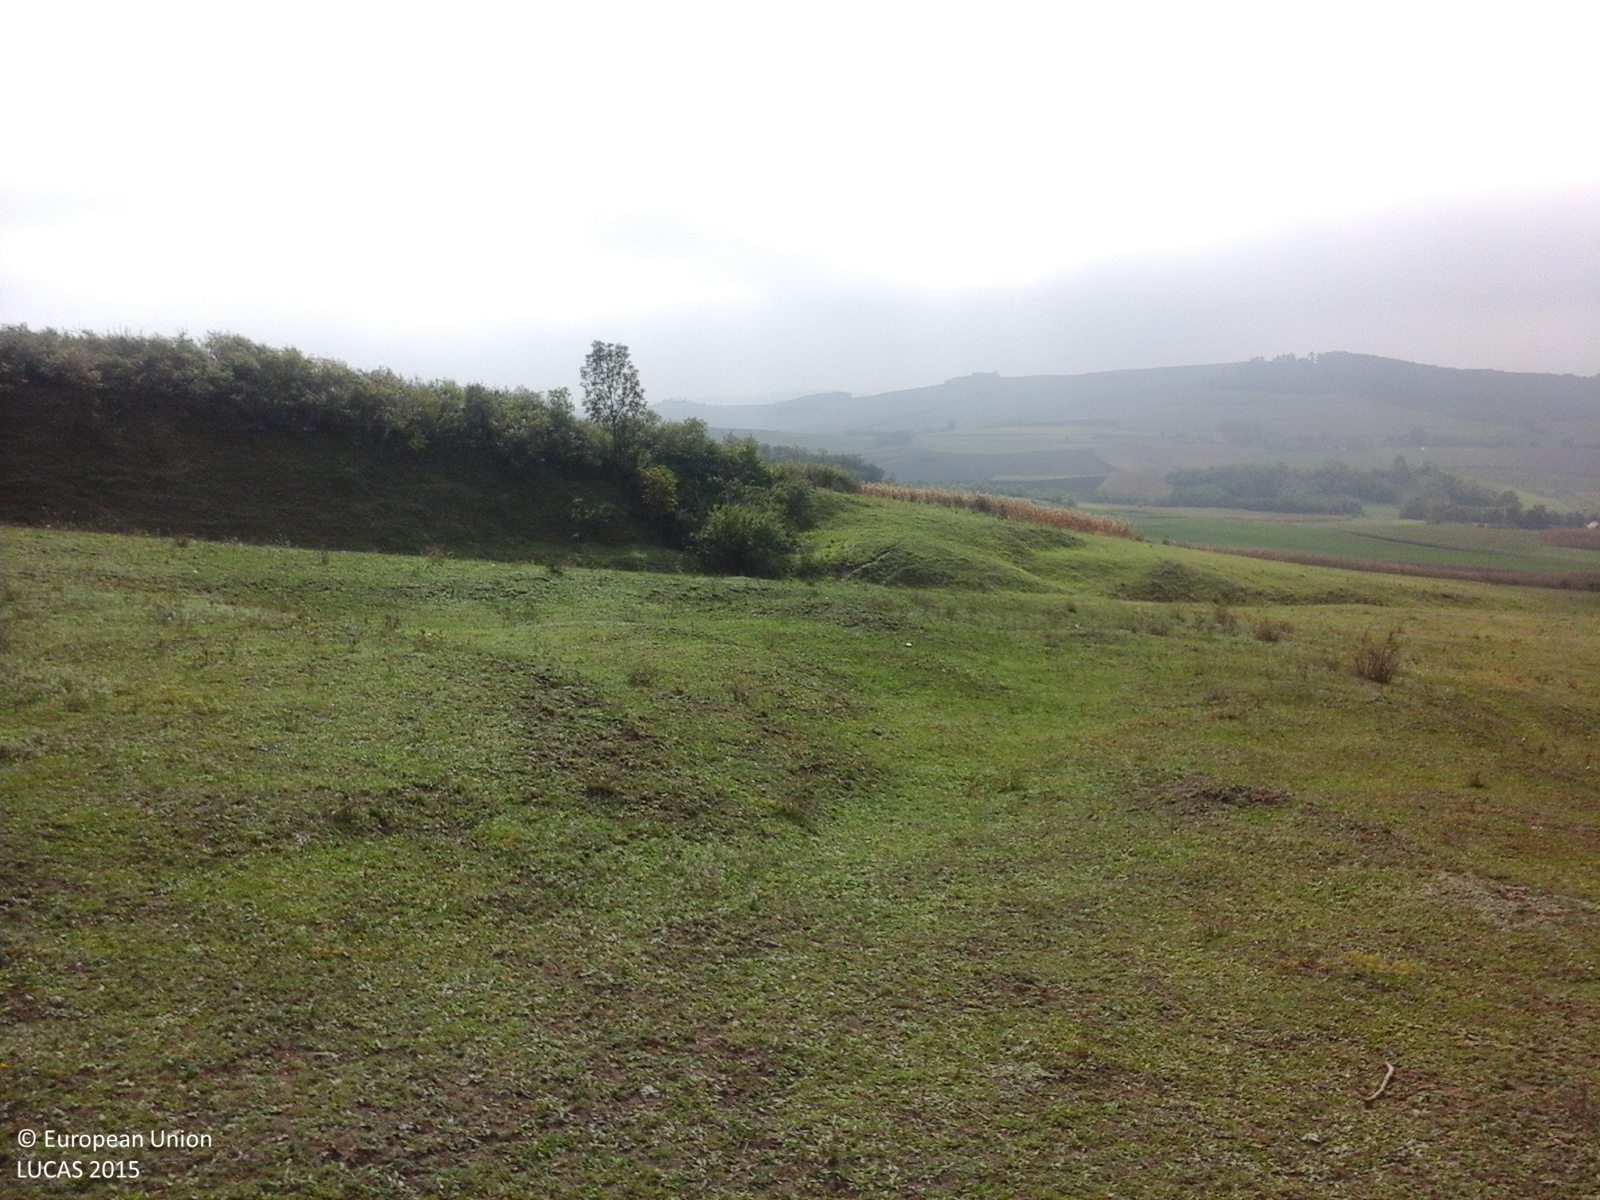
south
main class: Grassland
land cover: Grassland without tree/shrub cover
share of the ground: > 75 %
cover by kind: herbaceous plants 100 %
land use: Agriculture (excluding fallow land and kitchen gardens)
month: October
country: RO
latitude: 46.6371
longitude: 24.3629
